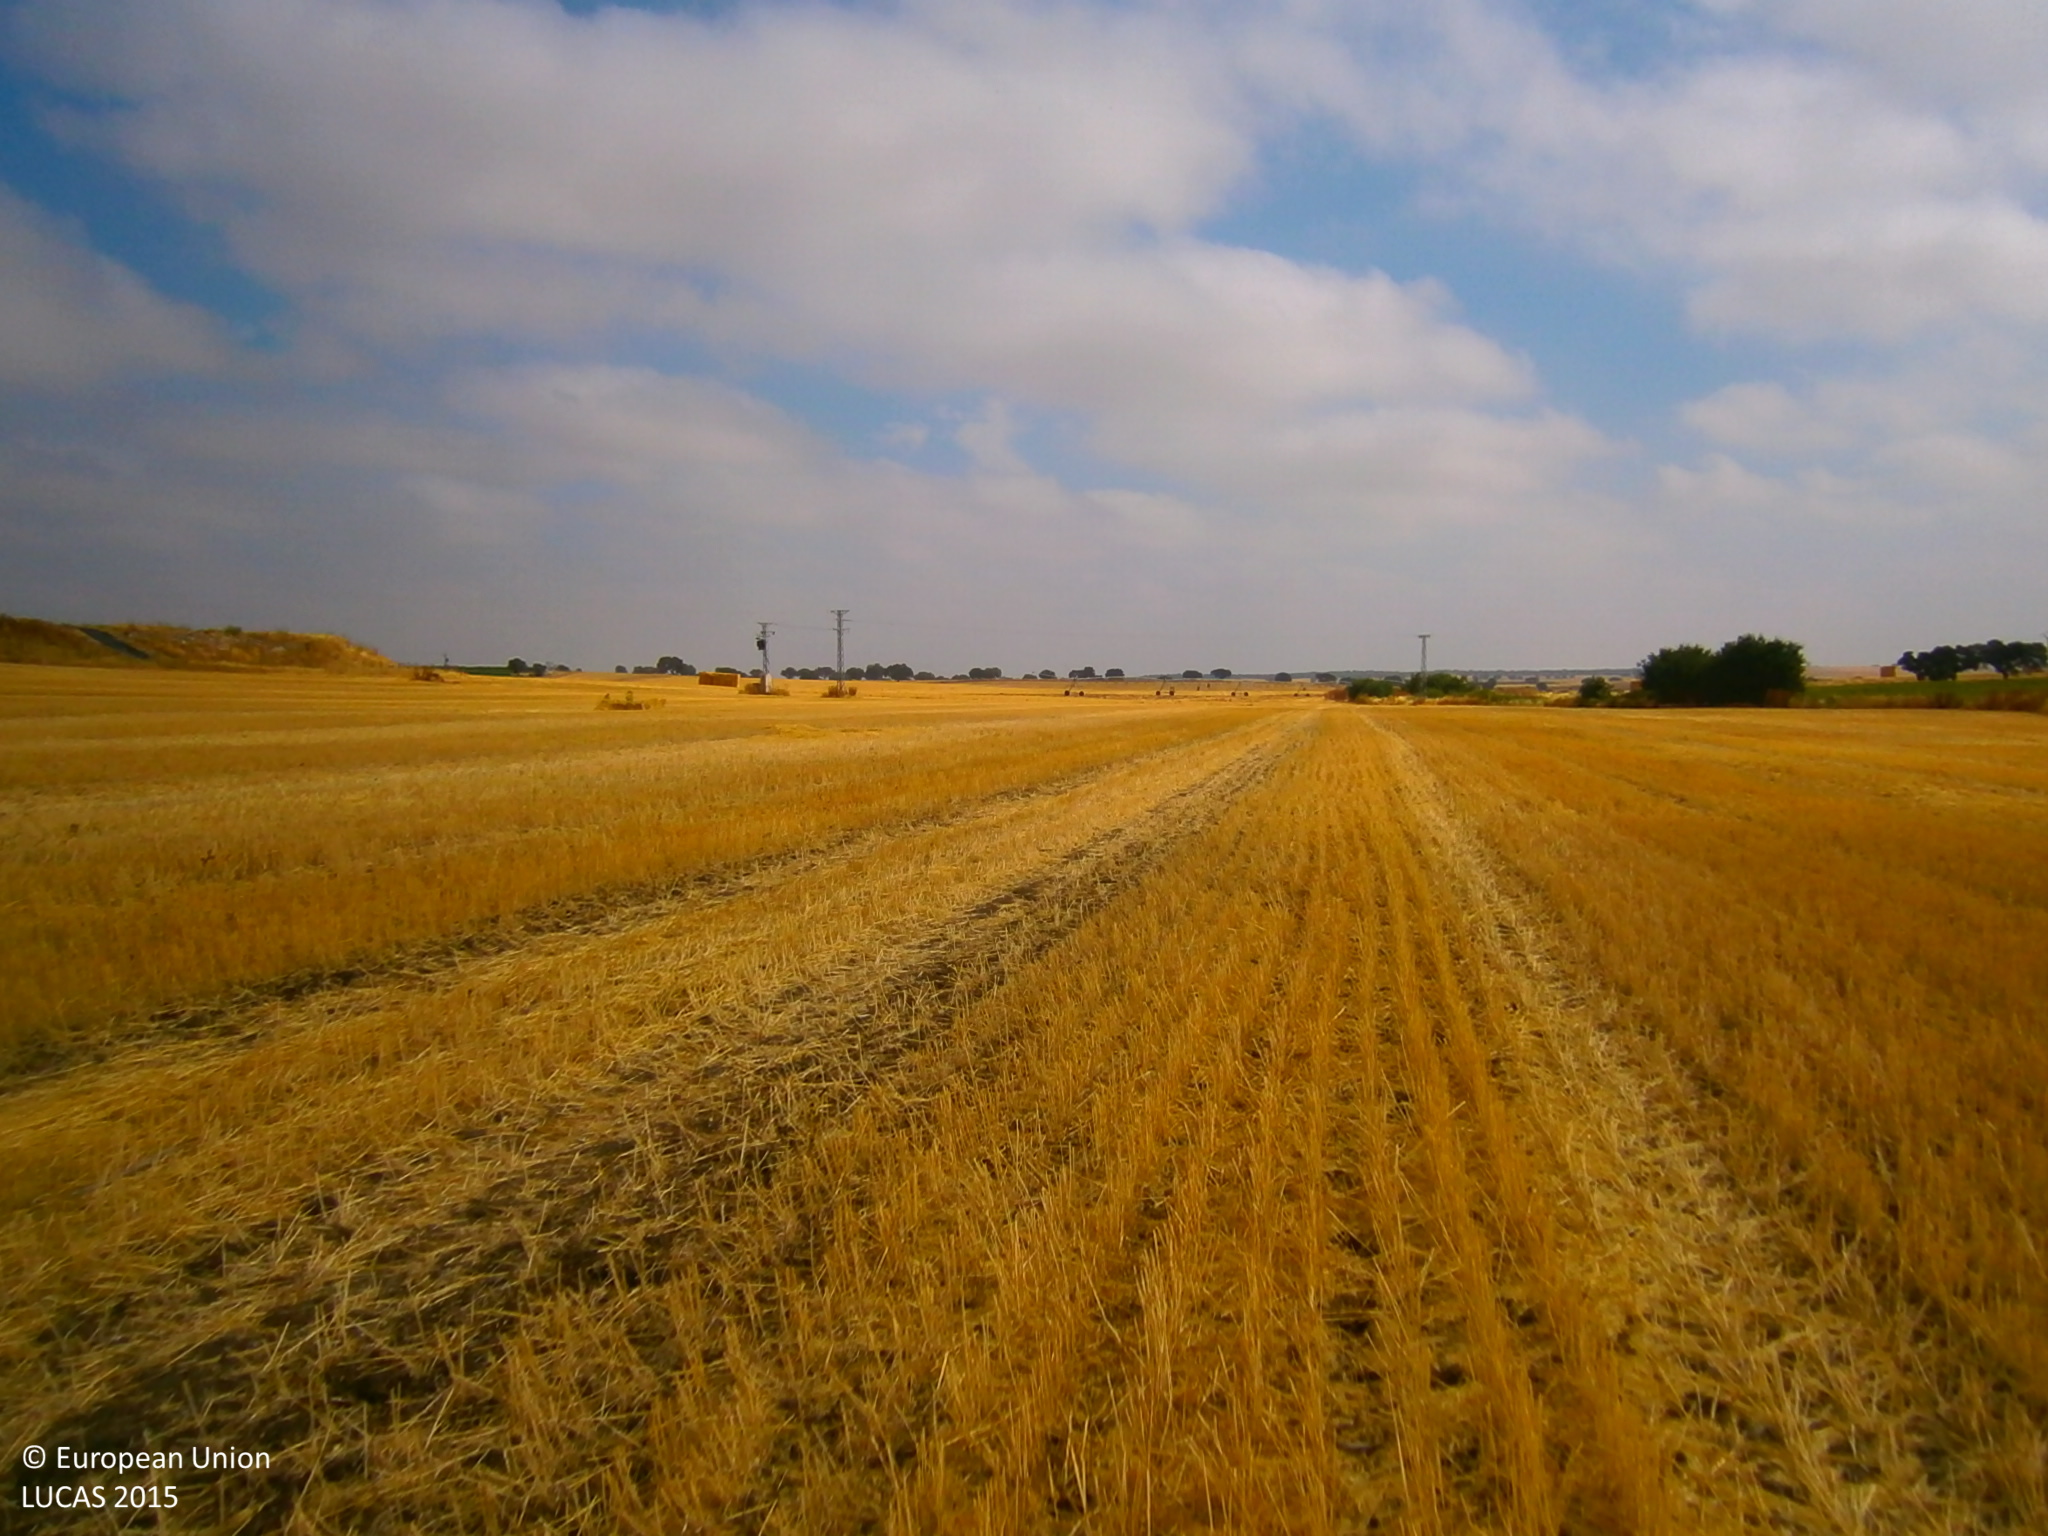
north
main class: Cropland
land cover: Durum wheat
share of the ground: > 75 %
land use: Agriculture (excluding fallow land and kitchen gardens)
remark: Harvested field
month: July
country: ES
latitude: 38.7226
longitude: -6.9631
